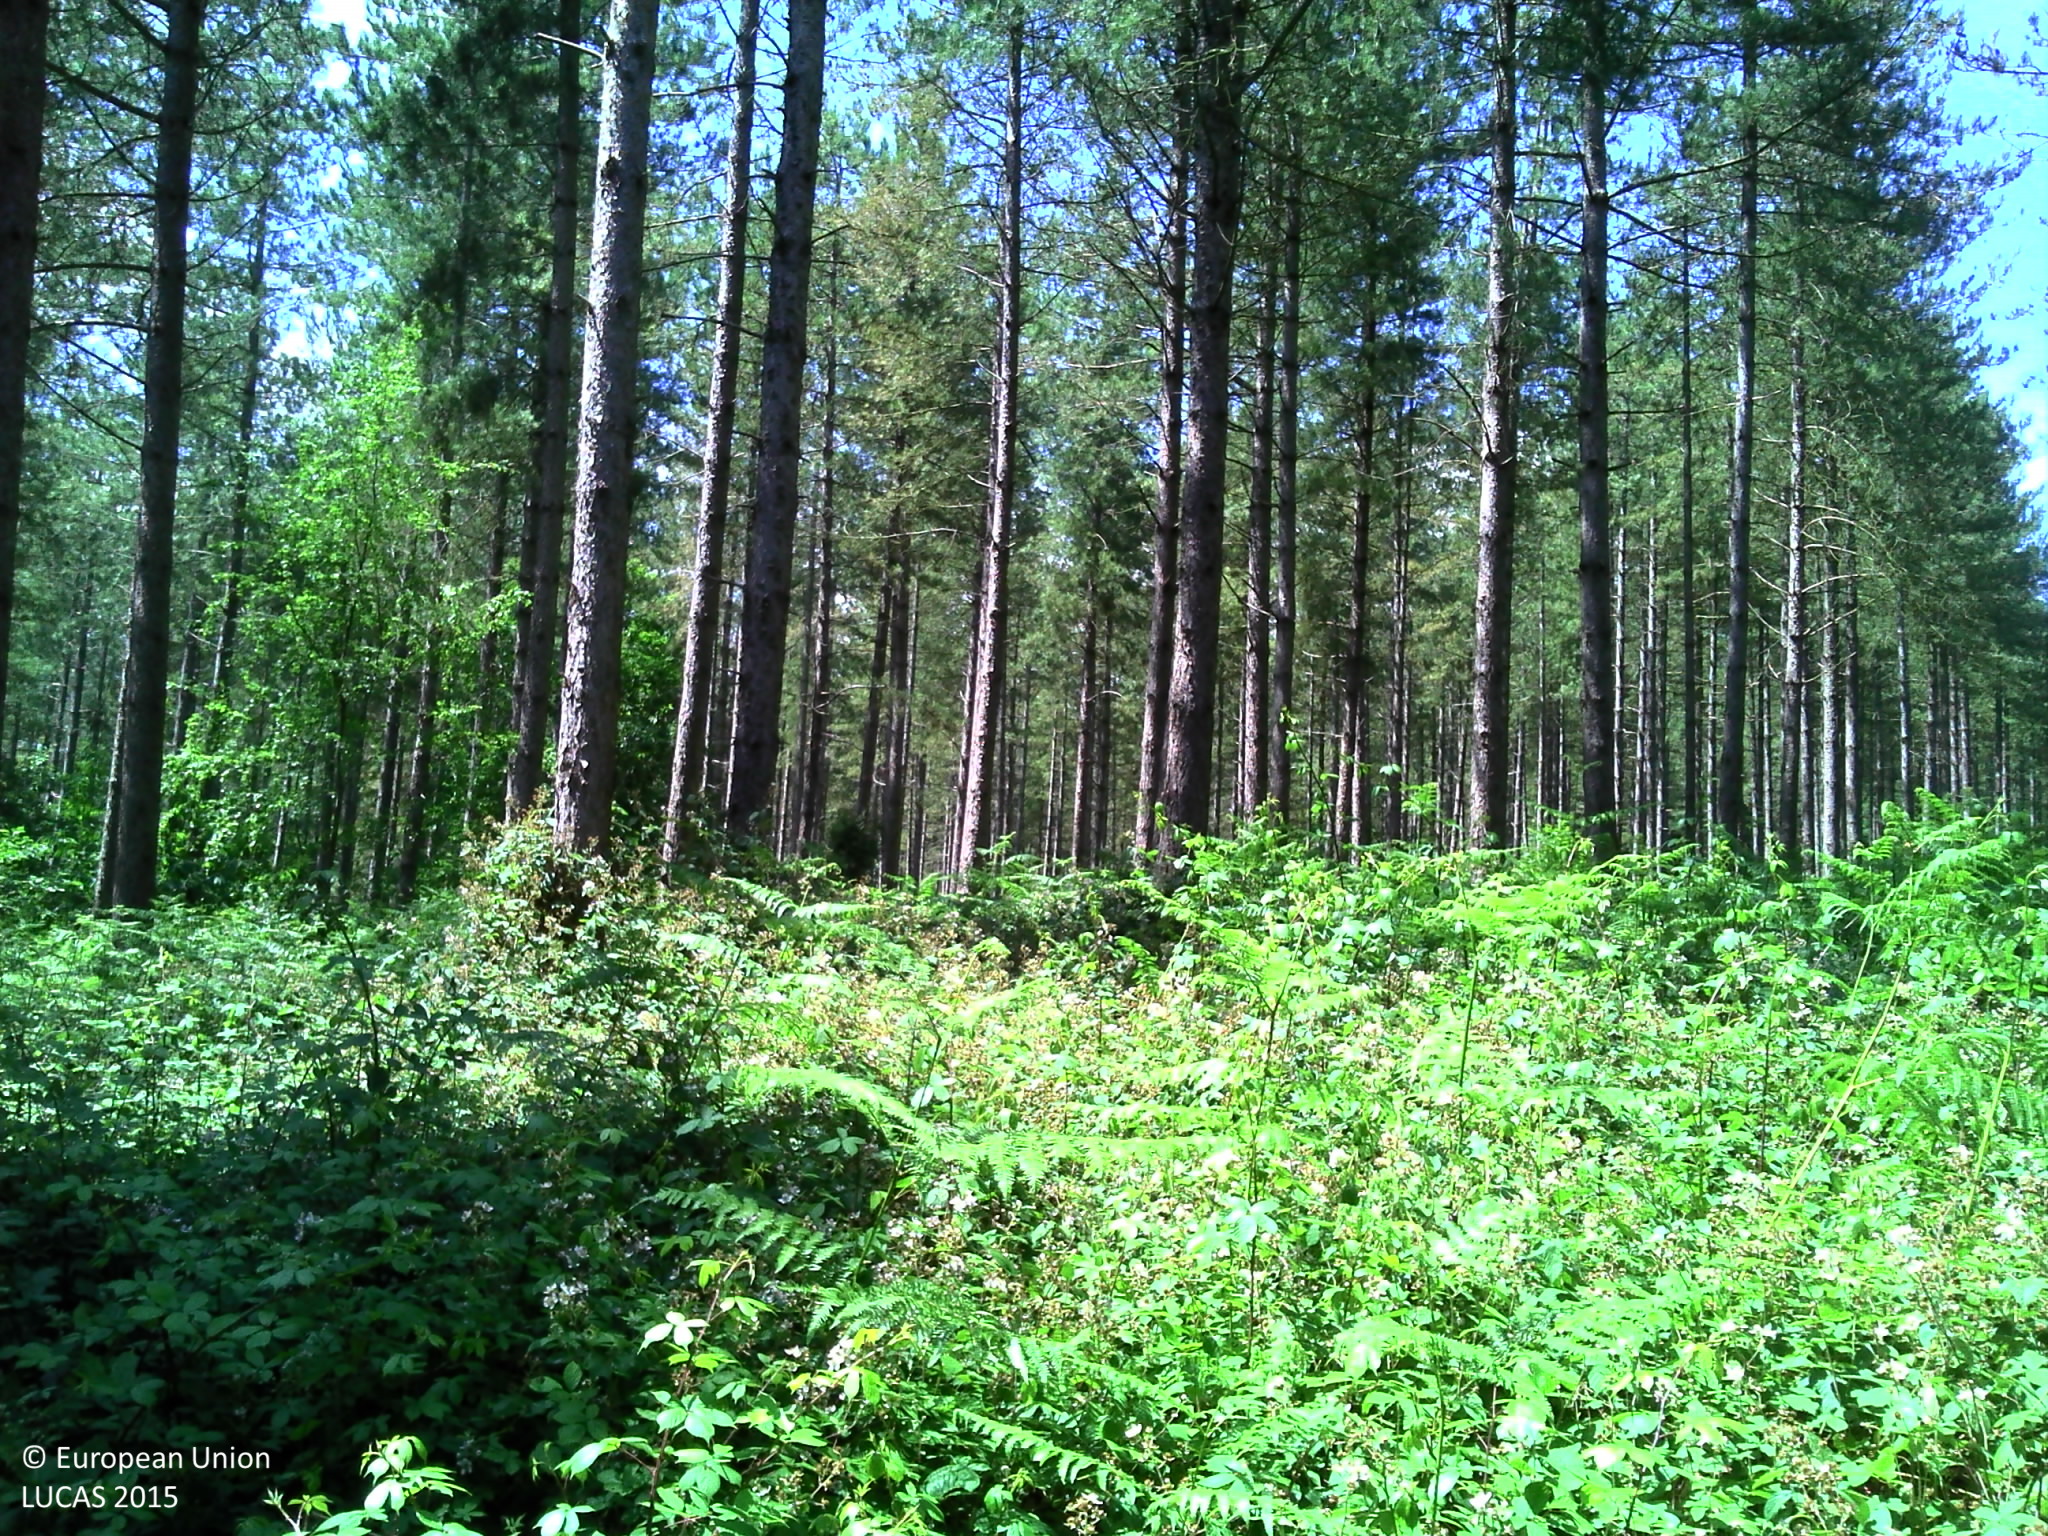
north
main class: Woodland
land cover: Pine dominated coniferous woodland
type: exotic forest
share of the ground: > 75 %
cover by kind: coniferous forest trees 80 %, herbaceous plants 20 %
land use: Forestry
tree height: > 5 m
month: June
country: FR
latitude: 49.3379
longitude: 1.2129
